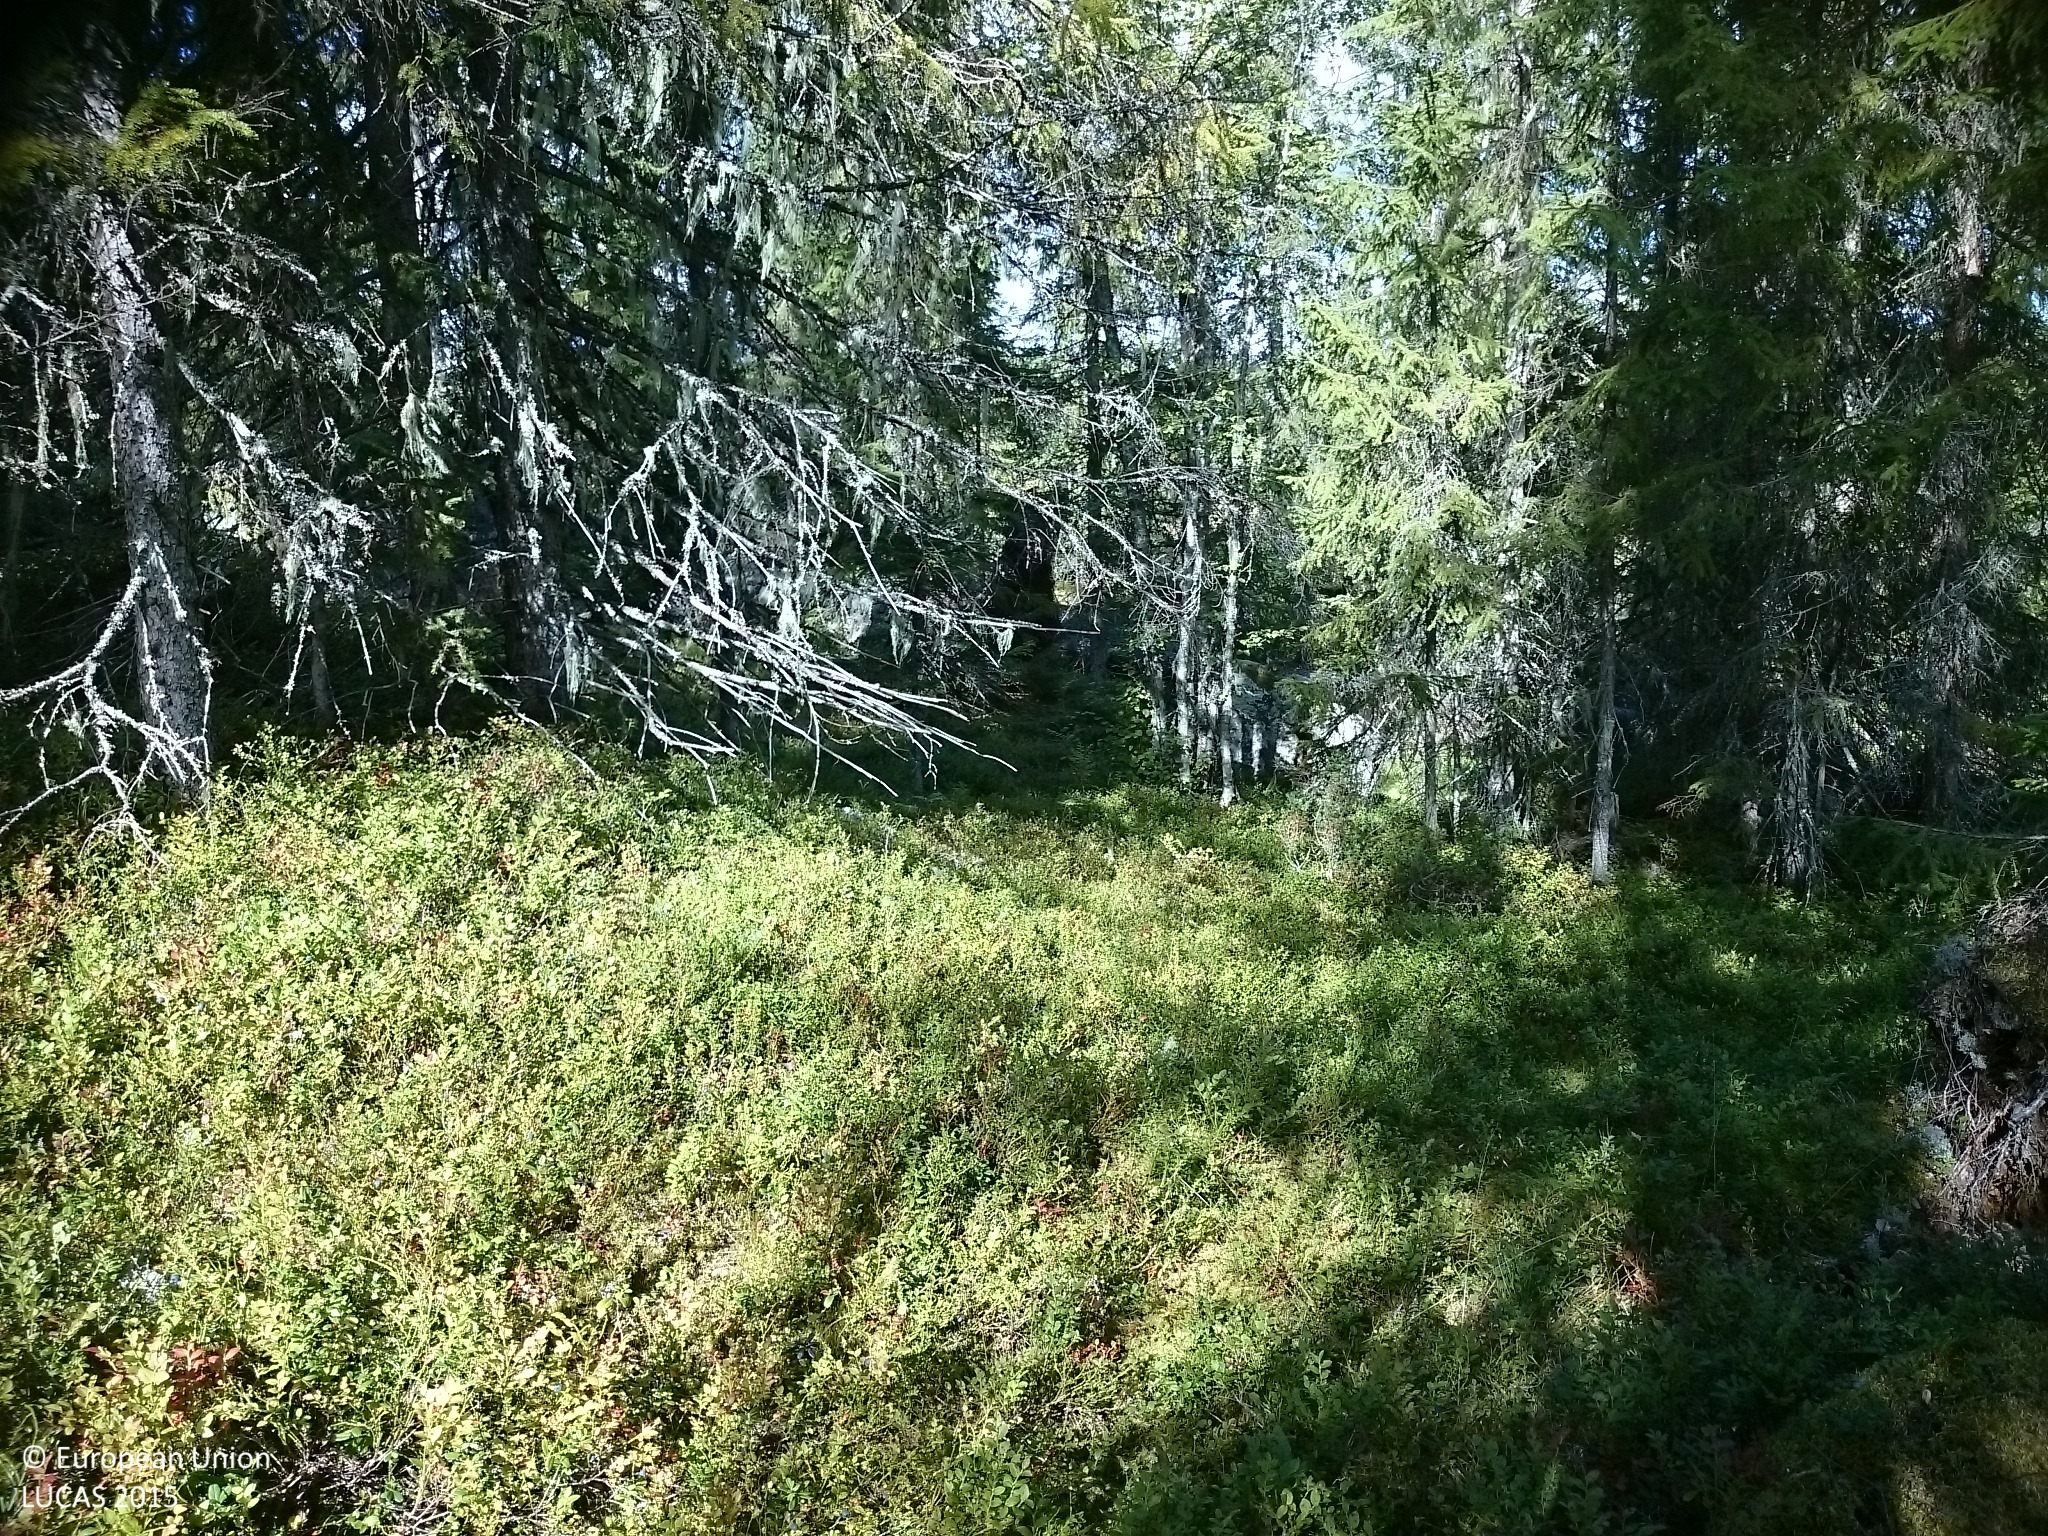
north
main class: Woodland
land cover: Spruce dominated coniferous woodland
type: boreal forest
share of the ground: 25 - 50 %
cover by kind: coniferous forest trees 50 %, shrubs 50 %
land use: Forestry
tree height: > 5 m
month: September
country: SE
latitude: 62.4184
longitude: 16.8912
